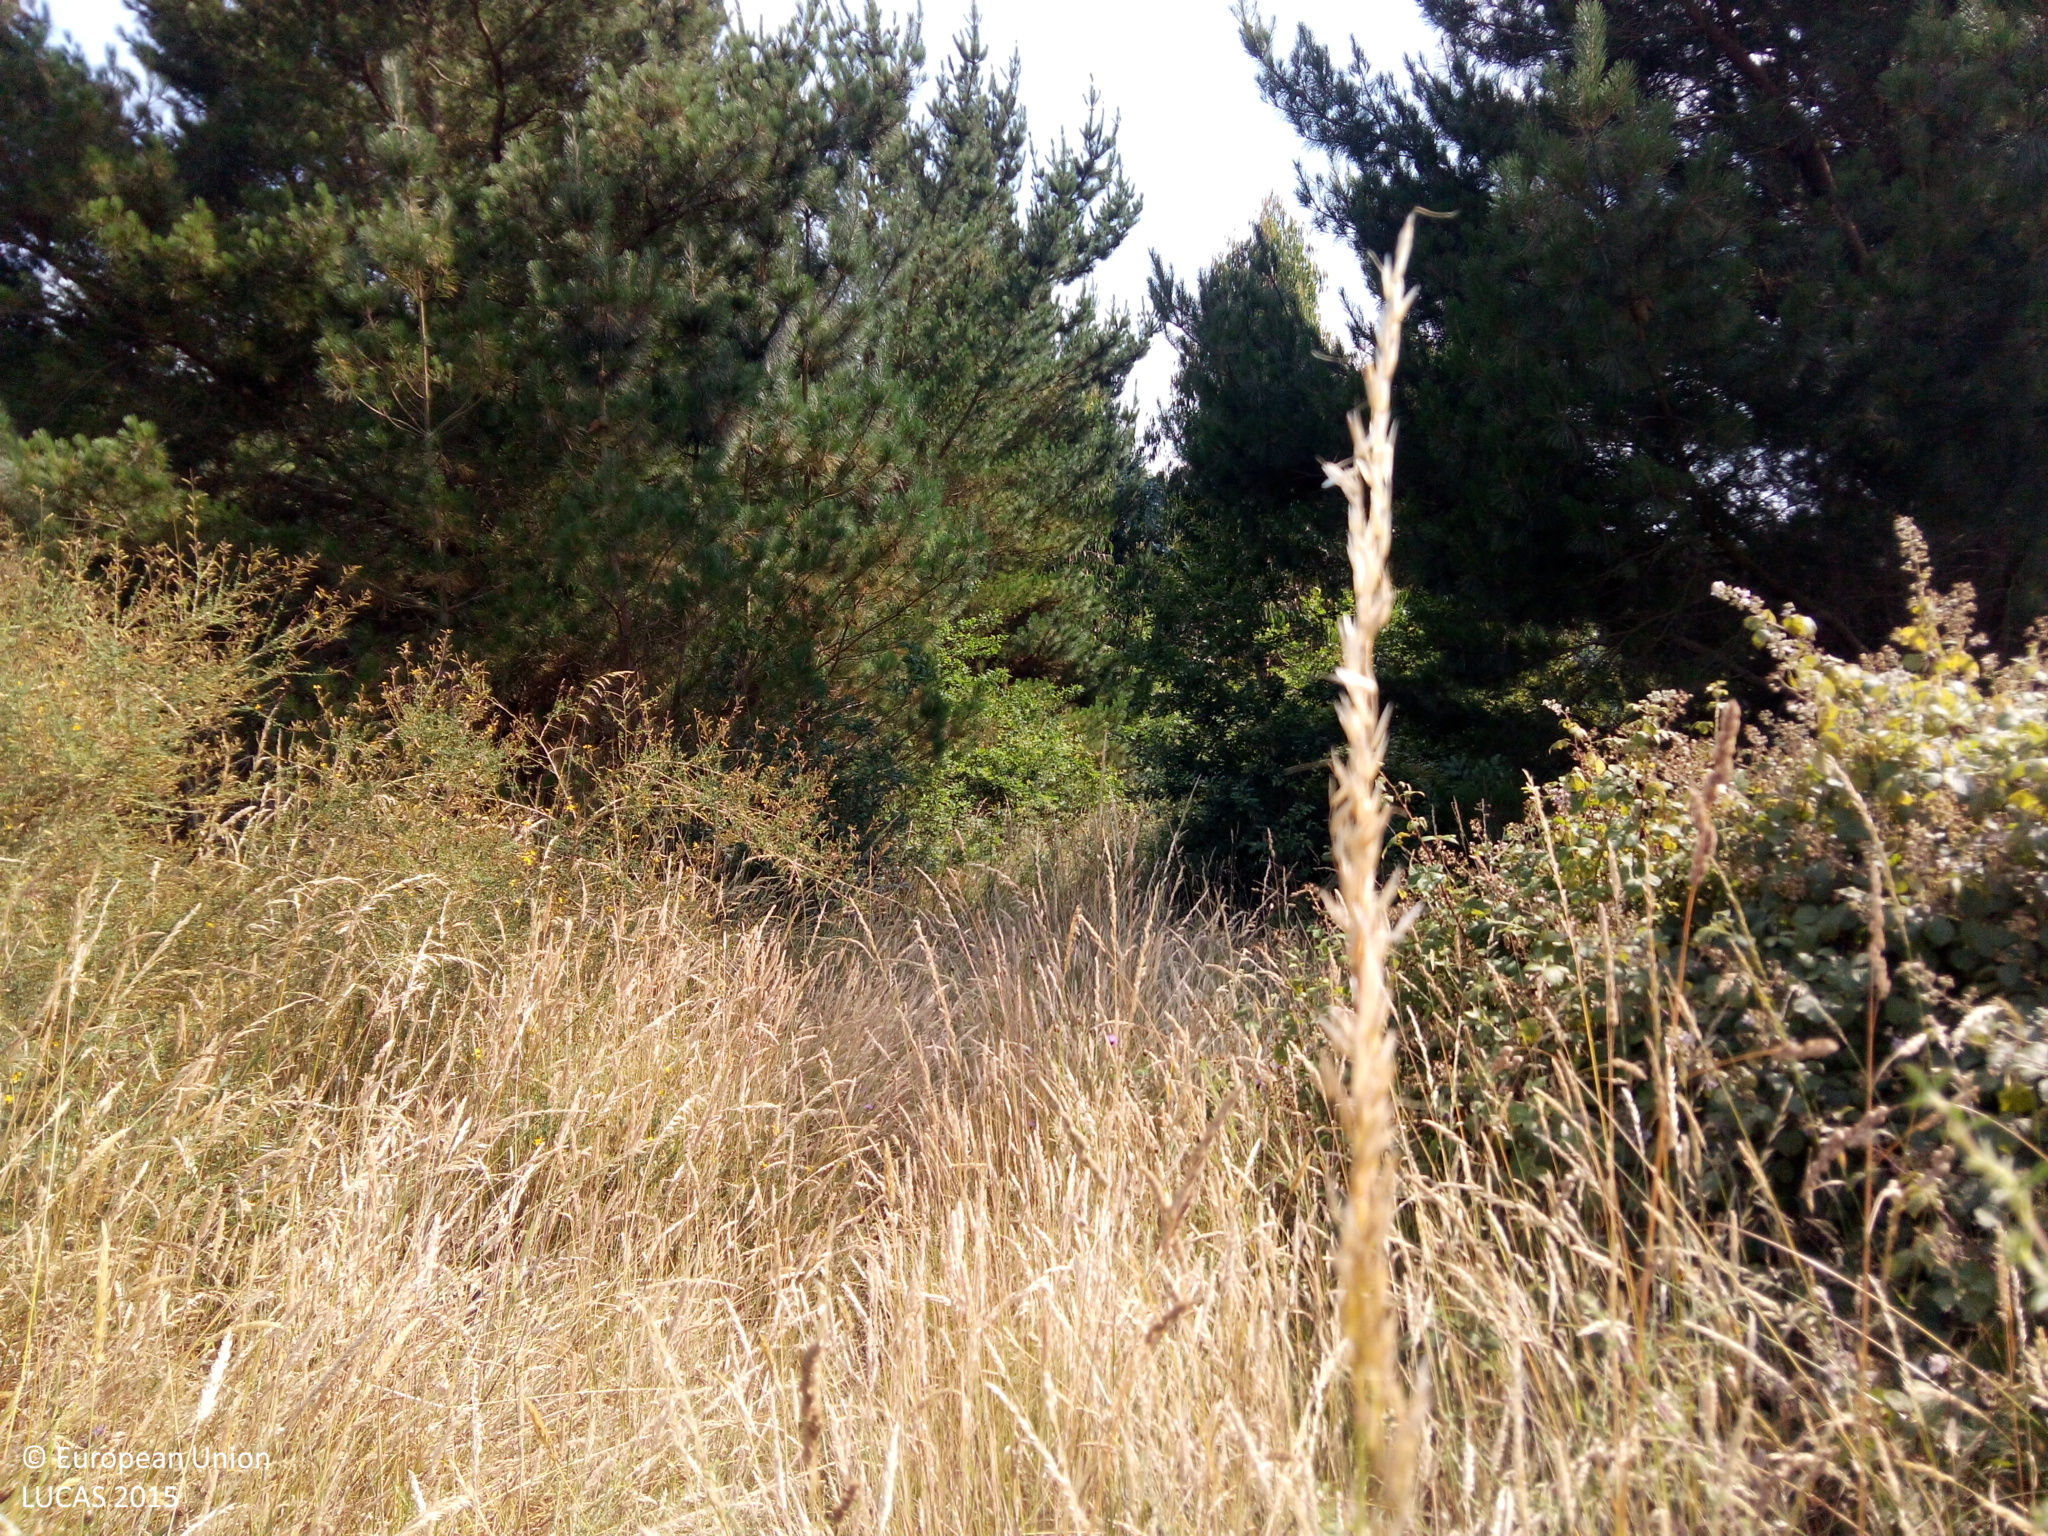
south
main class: Shrubland
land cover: Shrubland without tree cover
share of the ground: > 75 %
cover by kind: shrubs 100 %
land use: Abandoned areas
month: July
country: ES
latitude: 42.8367
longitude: -7.9862
